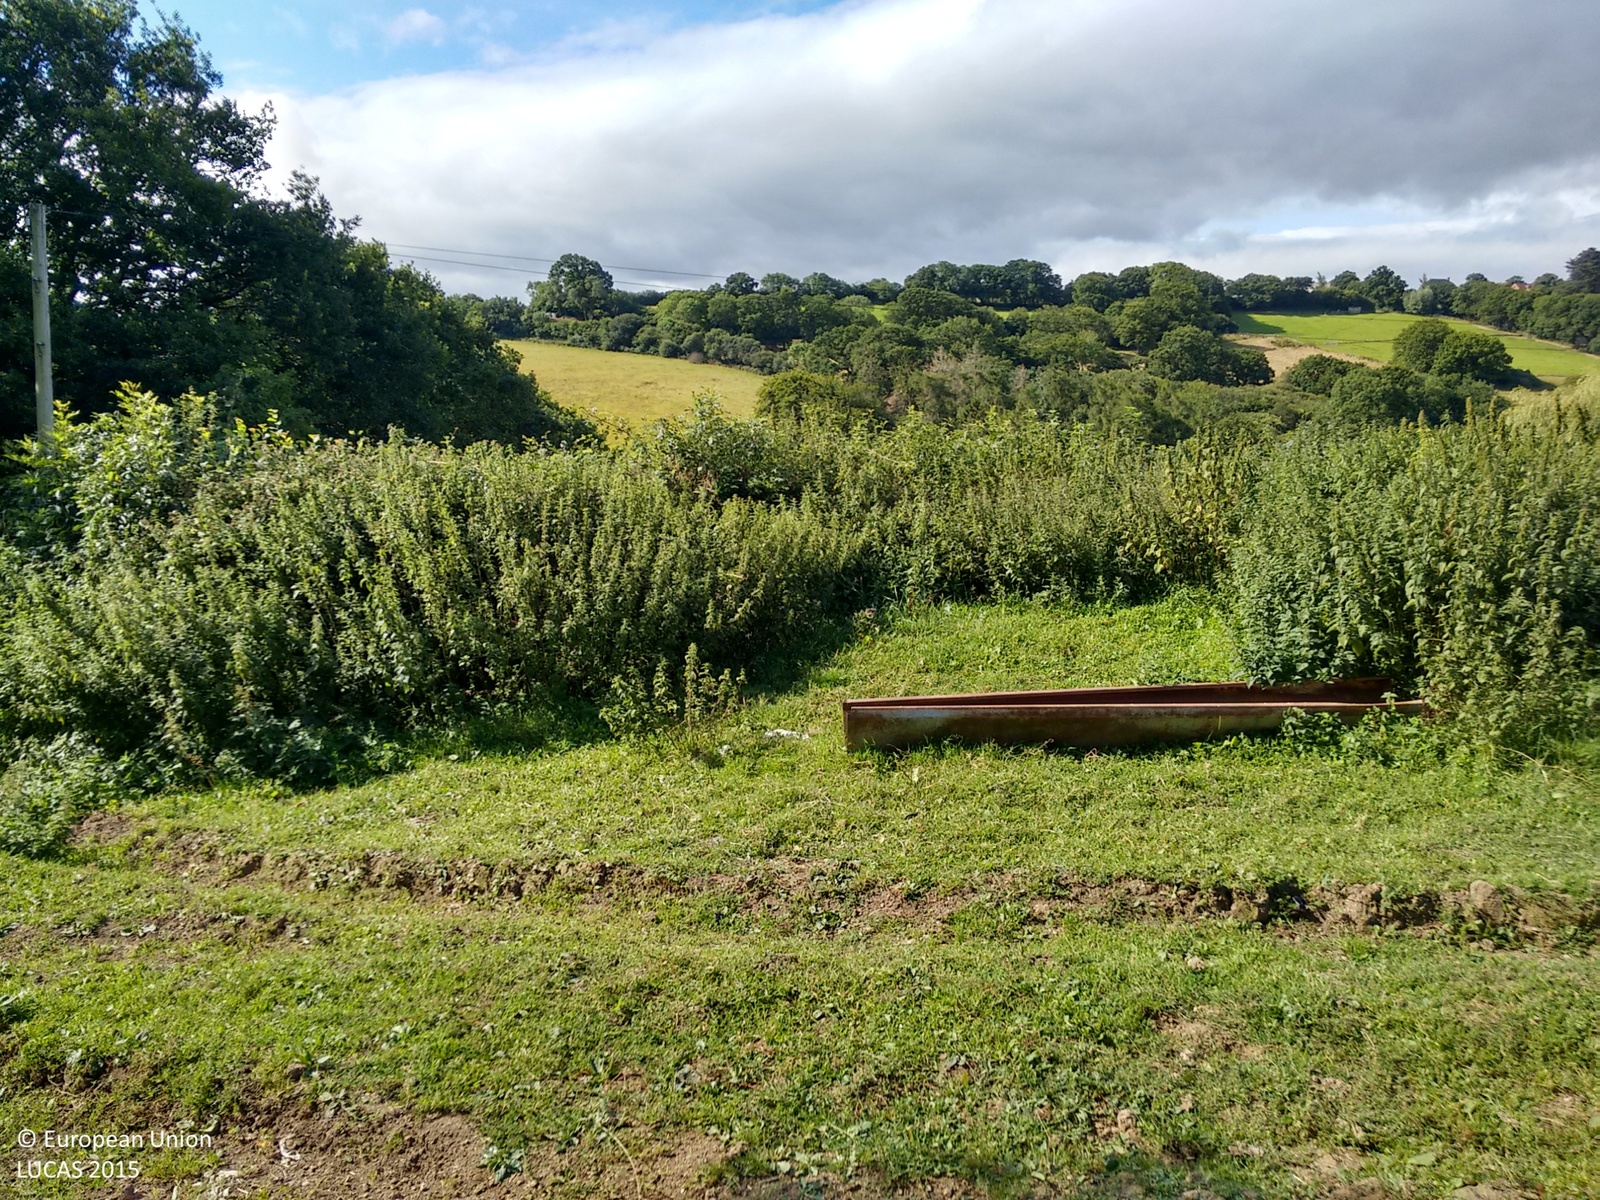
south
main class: Grassland
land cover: Grassland without tree/shrub cover
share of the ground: > 75 %
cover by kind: herbaceous plants 100 %
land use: Agriculture (excluding fallow land and kitchen gardens)
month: August
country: GB
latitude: 50.7339
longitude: -3.5884
